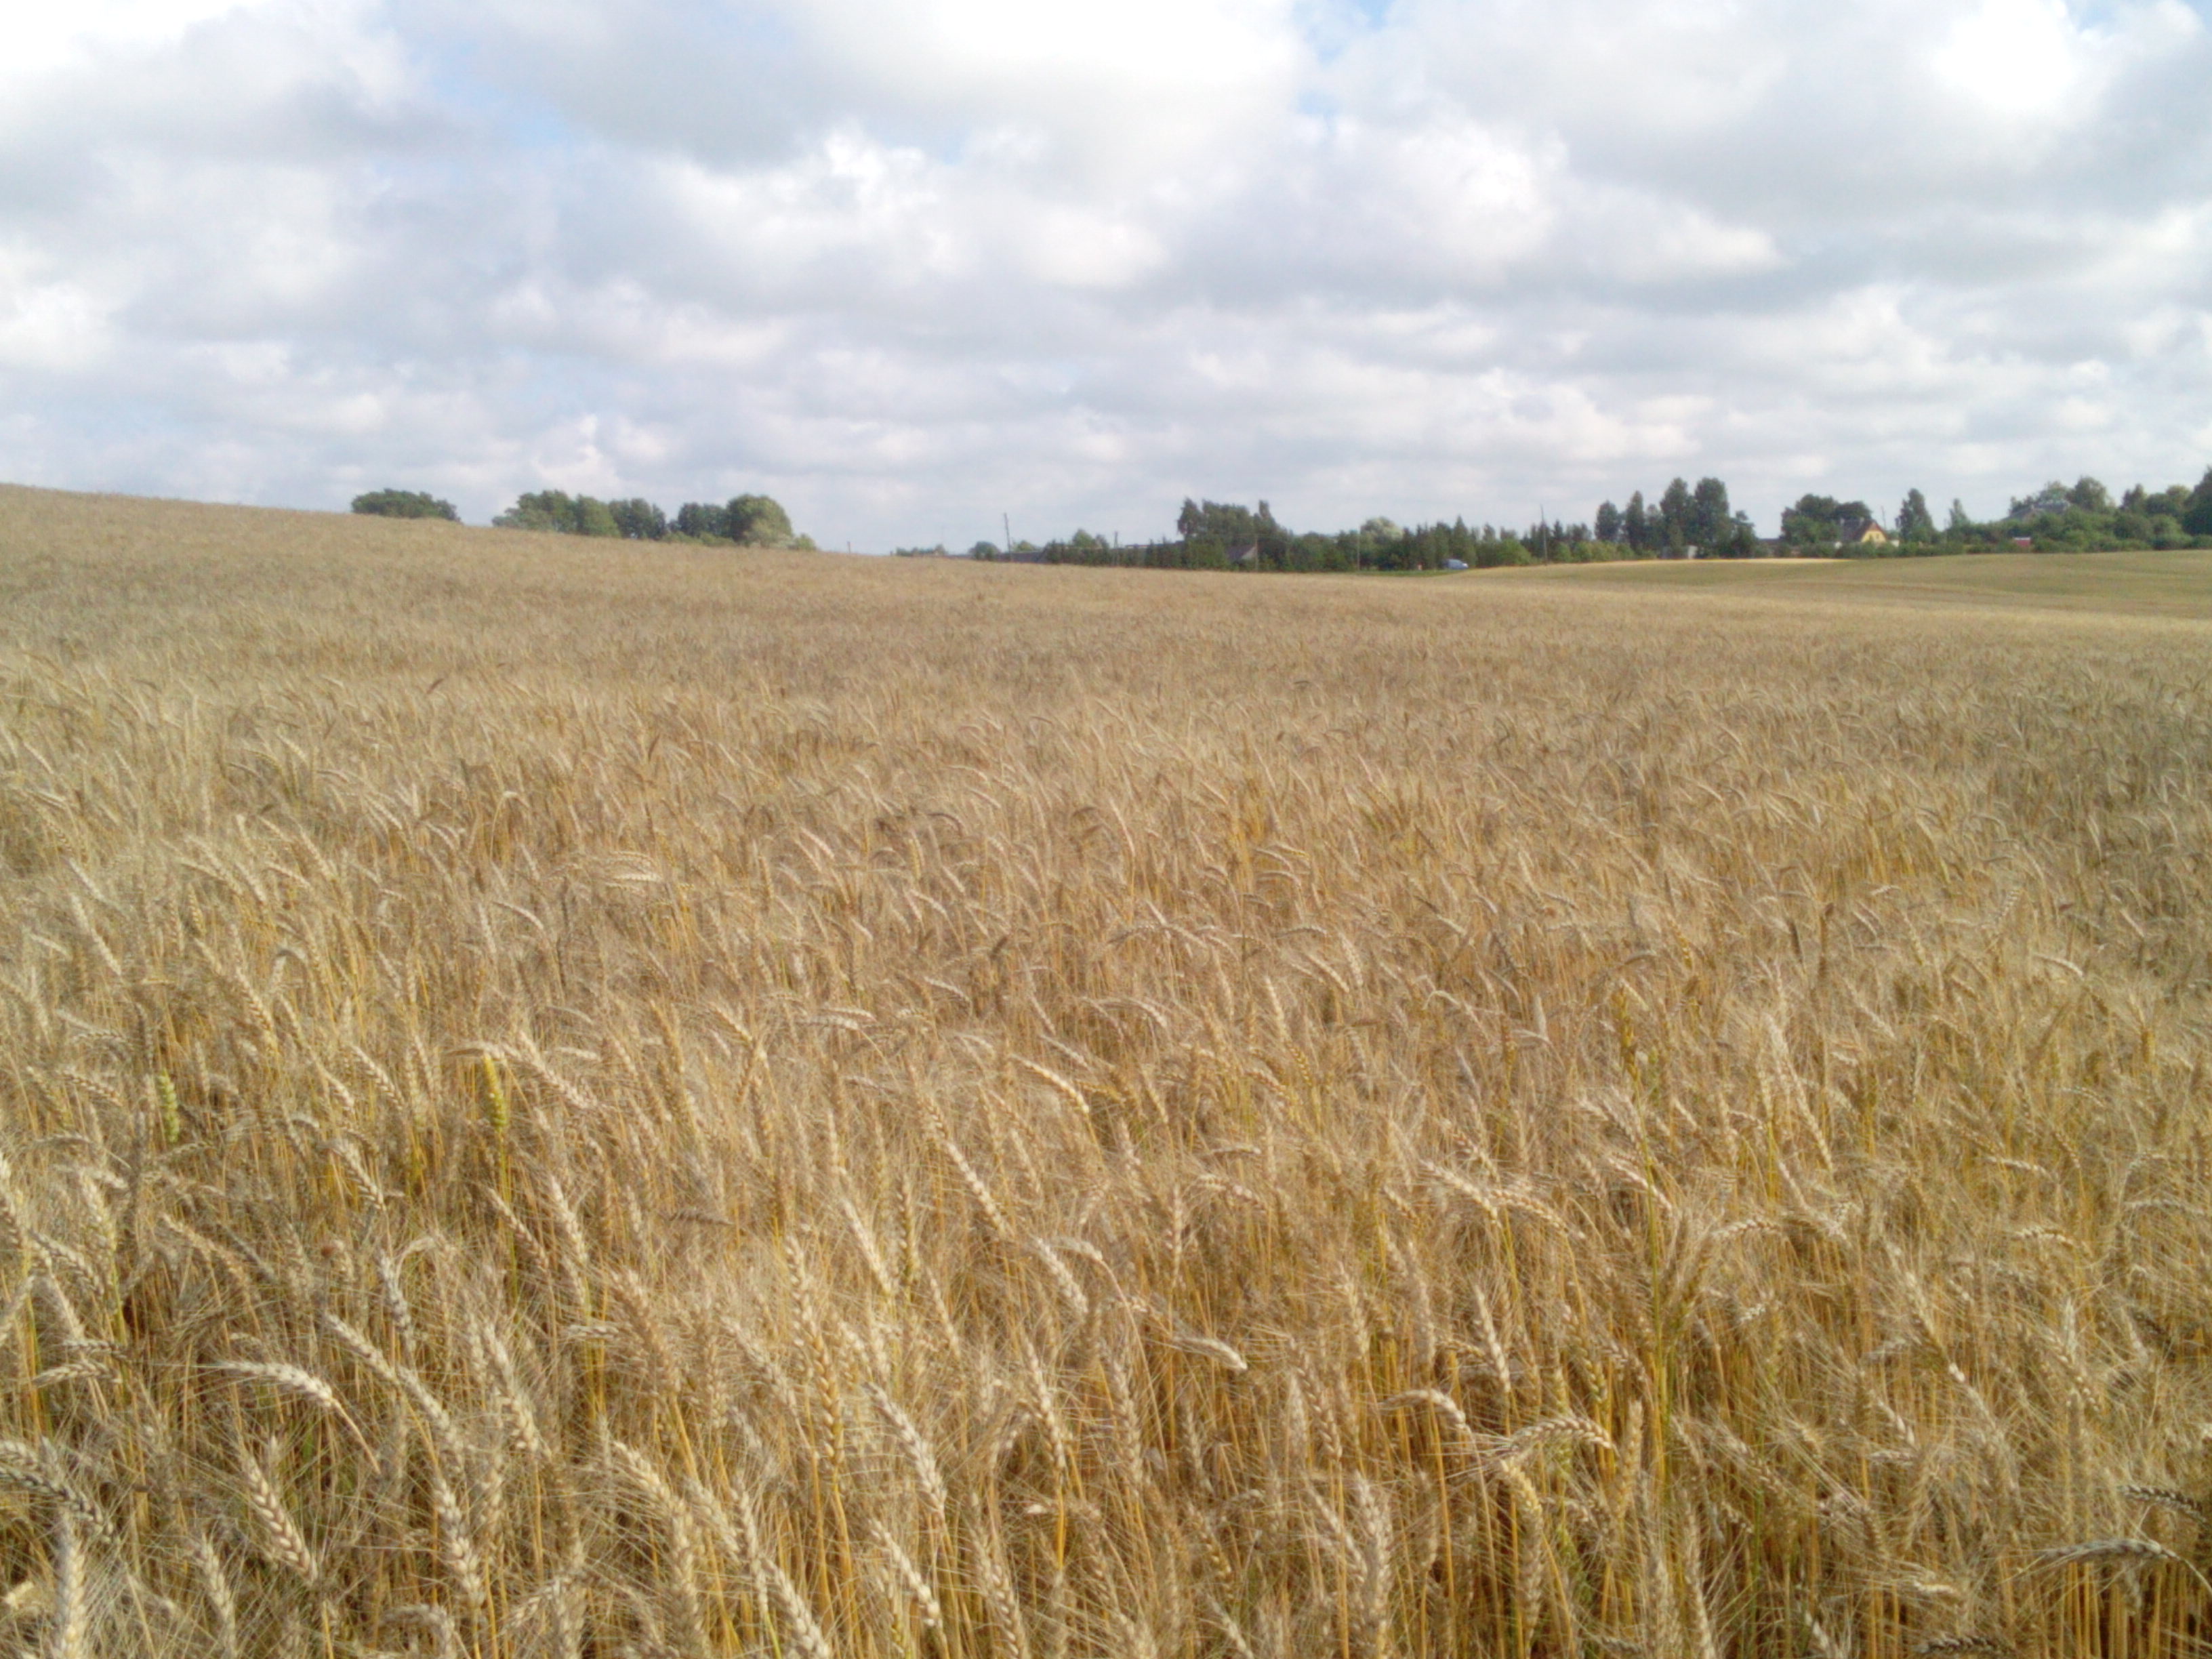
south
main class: Cropland
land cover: Common wheat
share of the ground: > 75 %
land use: Agriculture (excluding fallow land and kitchen gardens)
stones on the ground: 10 - 25 %
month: July
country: LV
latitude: 56.6494
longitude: 21.3090
